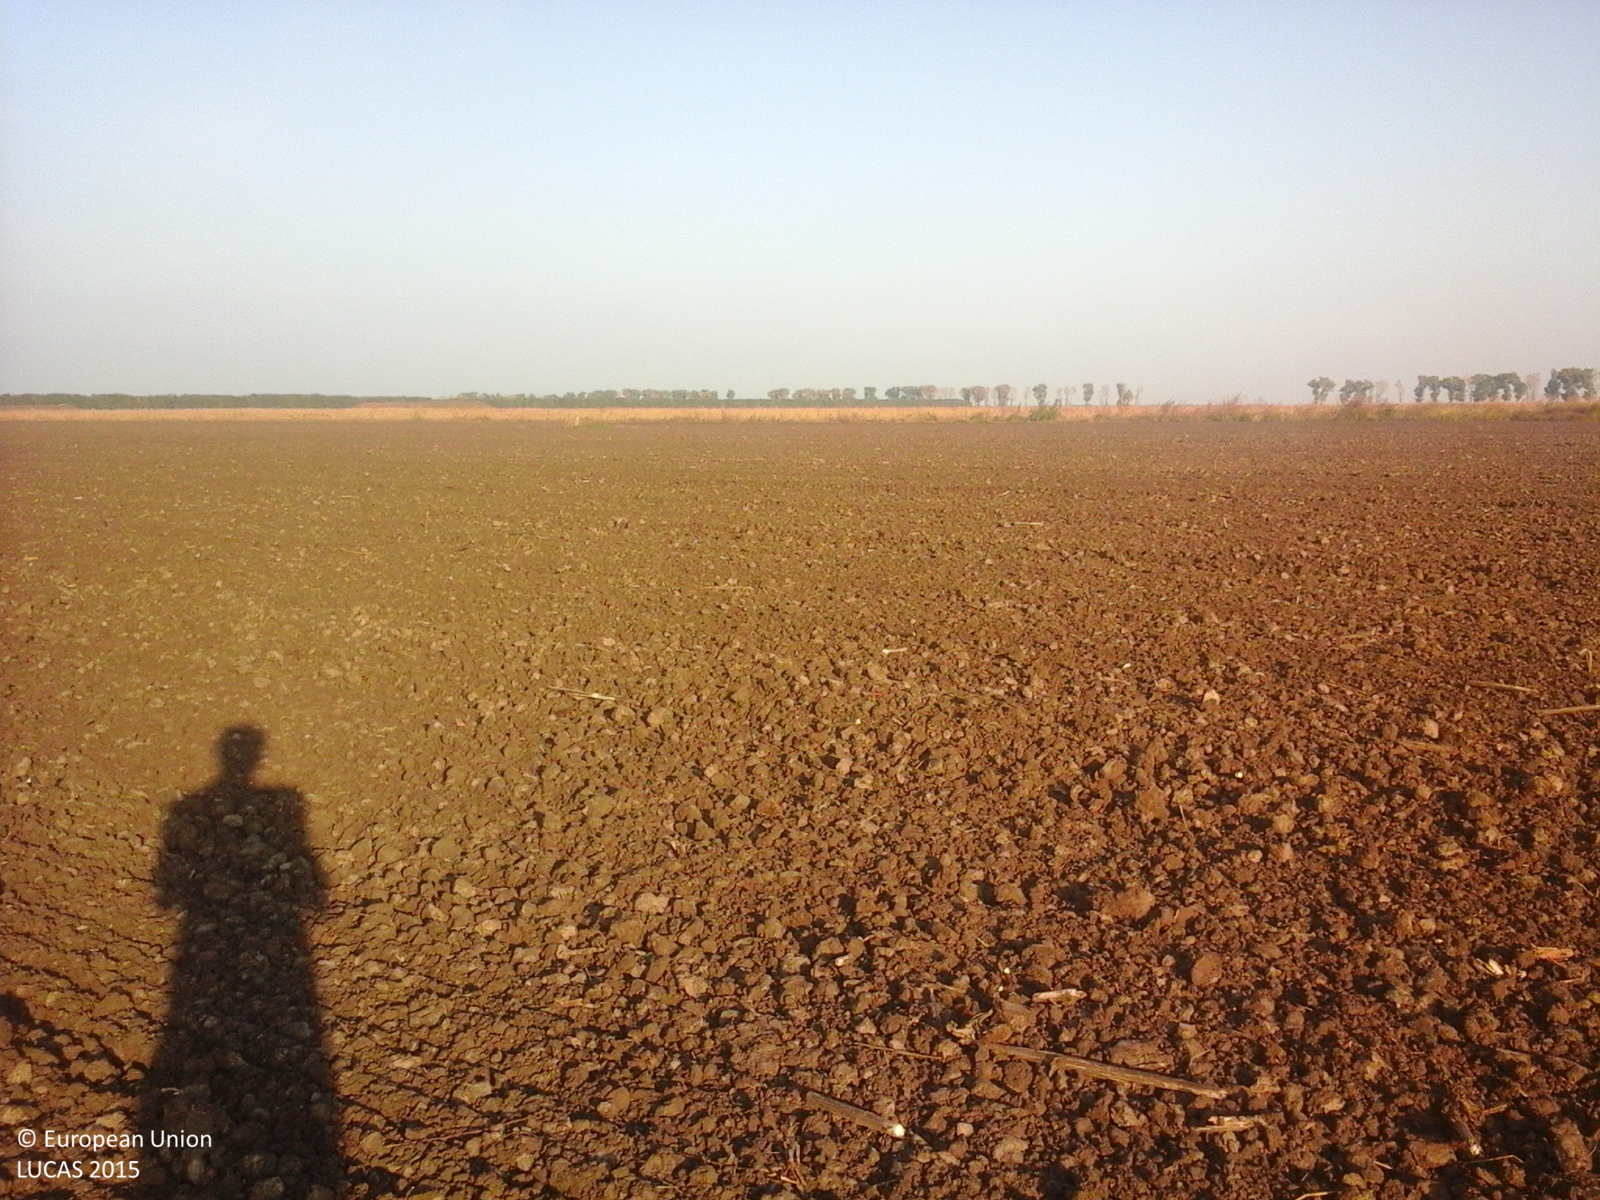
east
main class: Cropland
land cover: Sunflower
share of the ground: < 10 %
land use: Agriculture (excluding fallow land and kitchen gardens)
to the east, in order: Sunflower; Tracks; Shruby margins; Maize
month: October
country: RO
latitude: 45.2018
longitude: 26.9782
